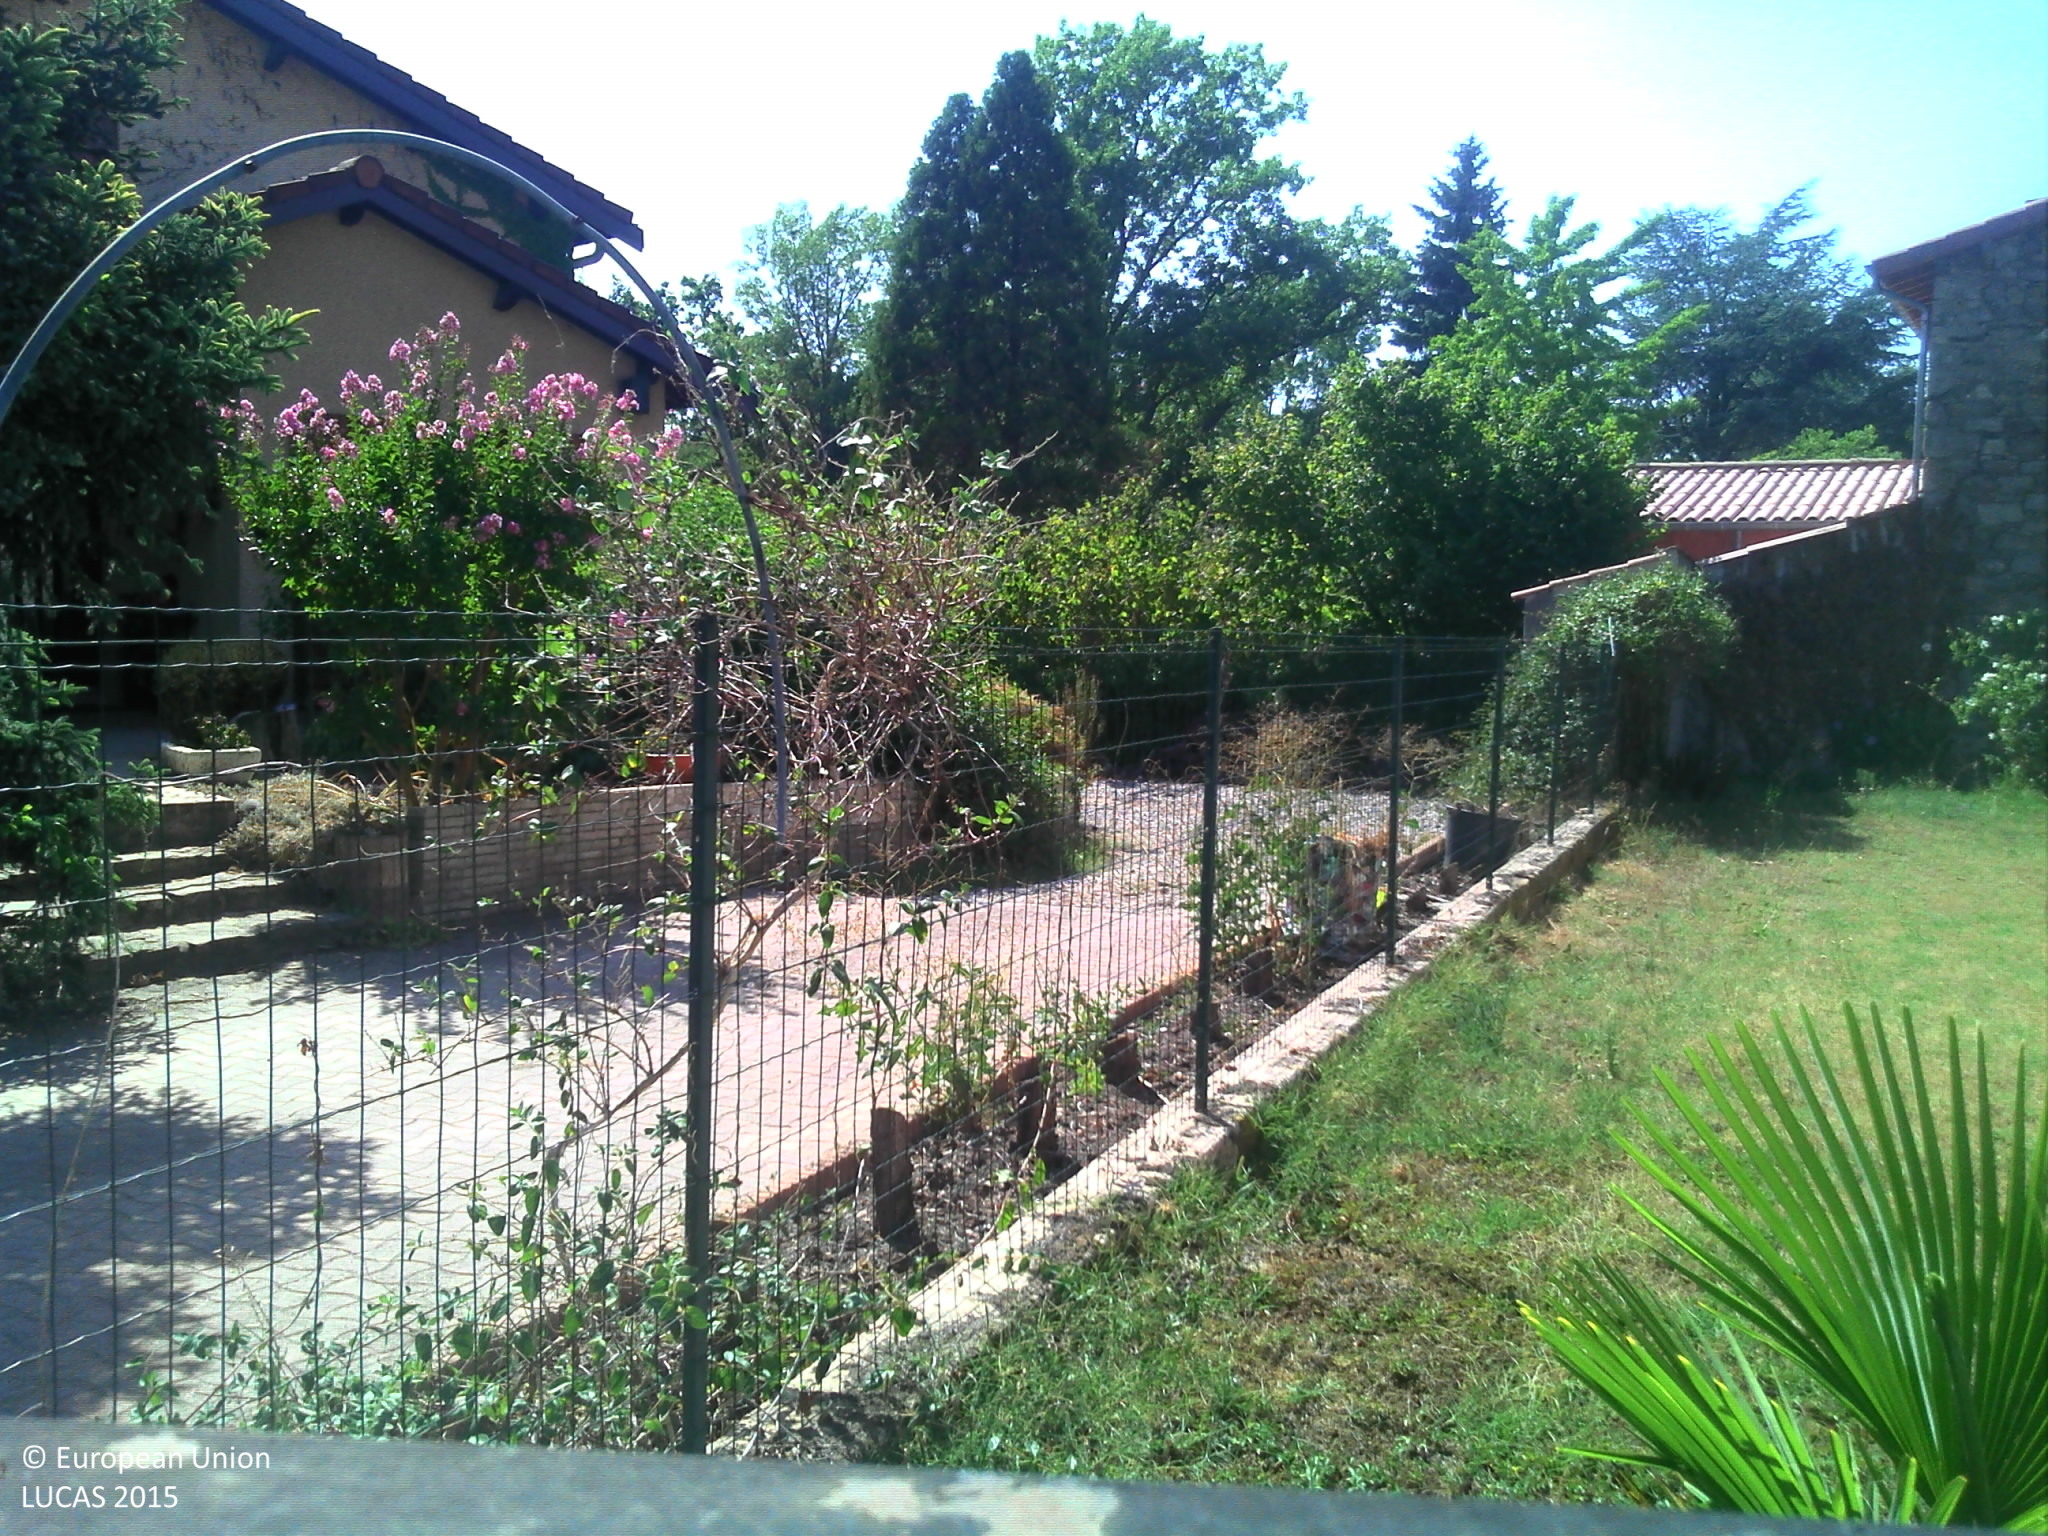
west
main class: Grassland
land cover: Grassland without tree/shrub cover
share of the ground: > 75 %
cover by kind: herbaceous plants 100 %
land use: Residential
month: August
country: FR
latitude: 45.6065
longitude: 4.7084
